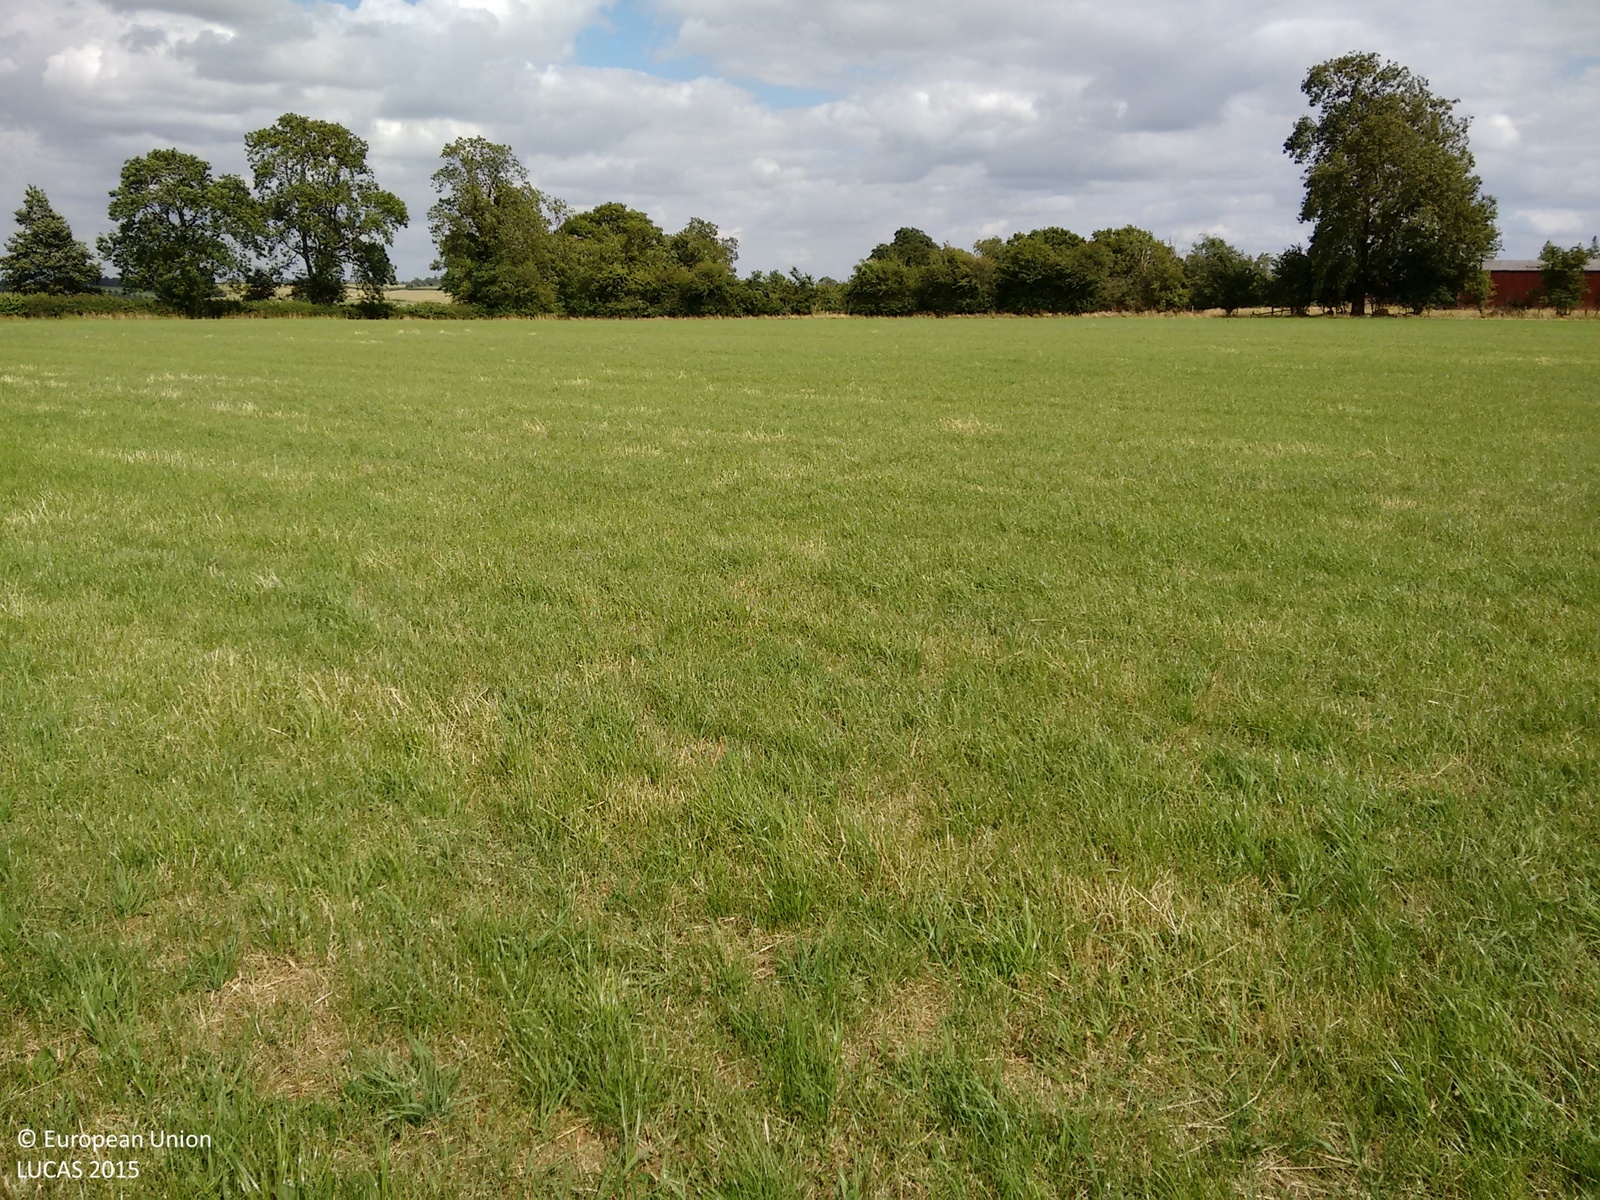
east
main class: Grassland
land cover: Grassland without tree/shrub cover
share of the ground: > 75 %
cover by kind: herbaceous plants 100 %
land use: Agriculture (excluding fallow land and kitchen gardens)
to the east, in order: Grassland without tree/shrub cover; Fences; Managed hedges; Grassland without tree/shrub cover; Fences; Abandoned hedges; Grassland without tree/shrub cover
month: July
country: GB
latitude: 52.6658
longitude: -0.9710
